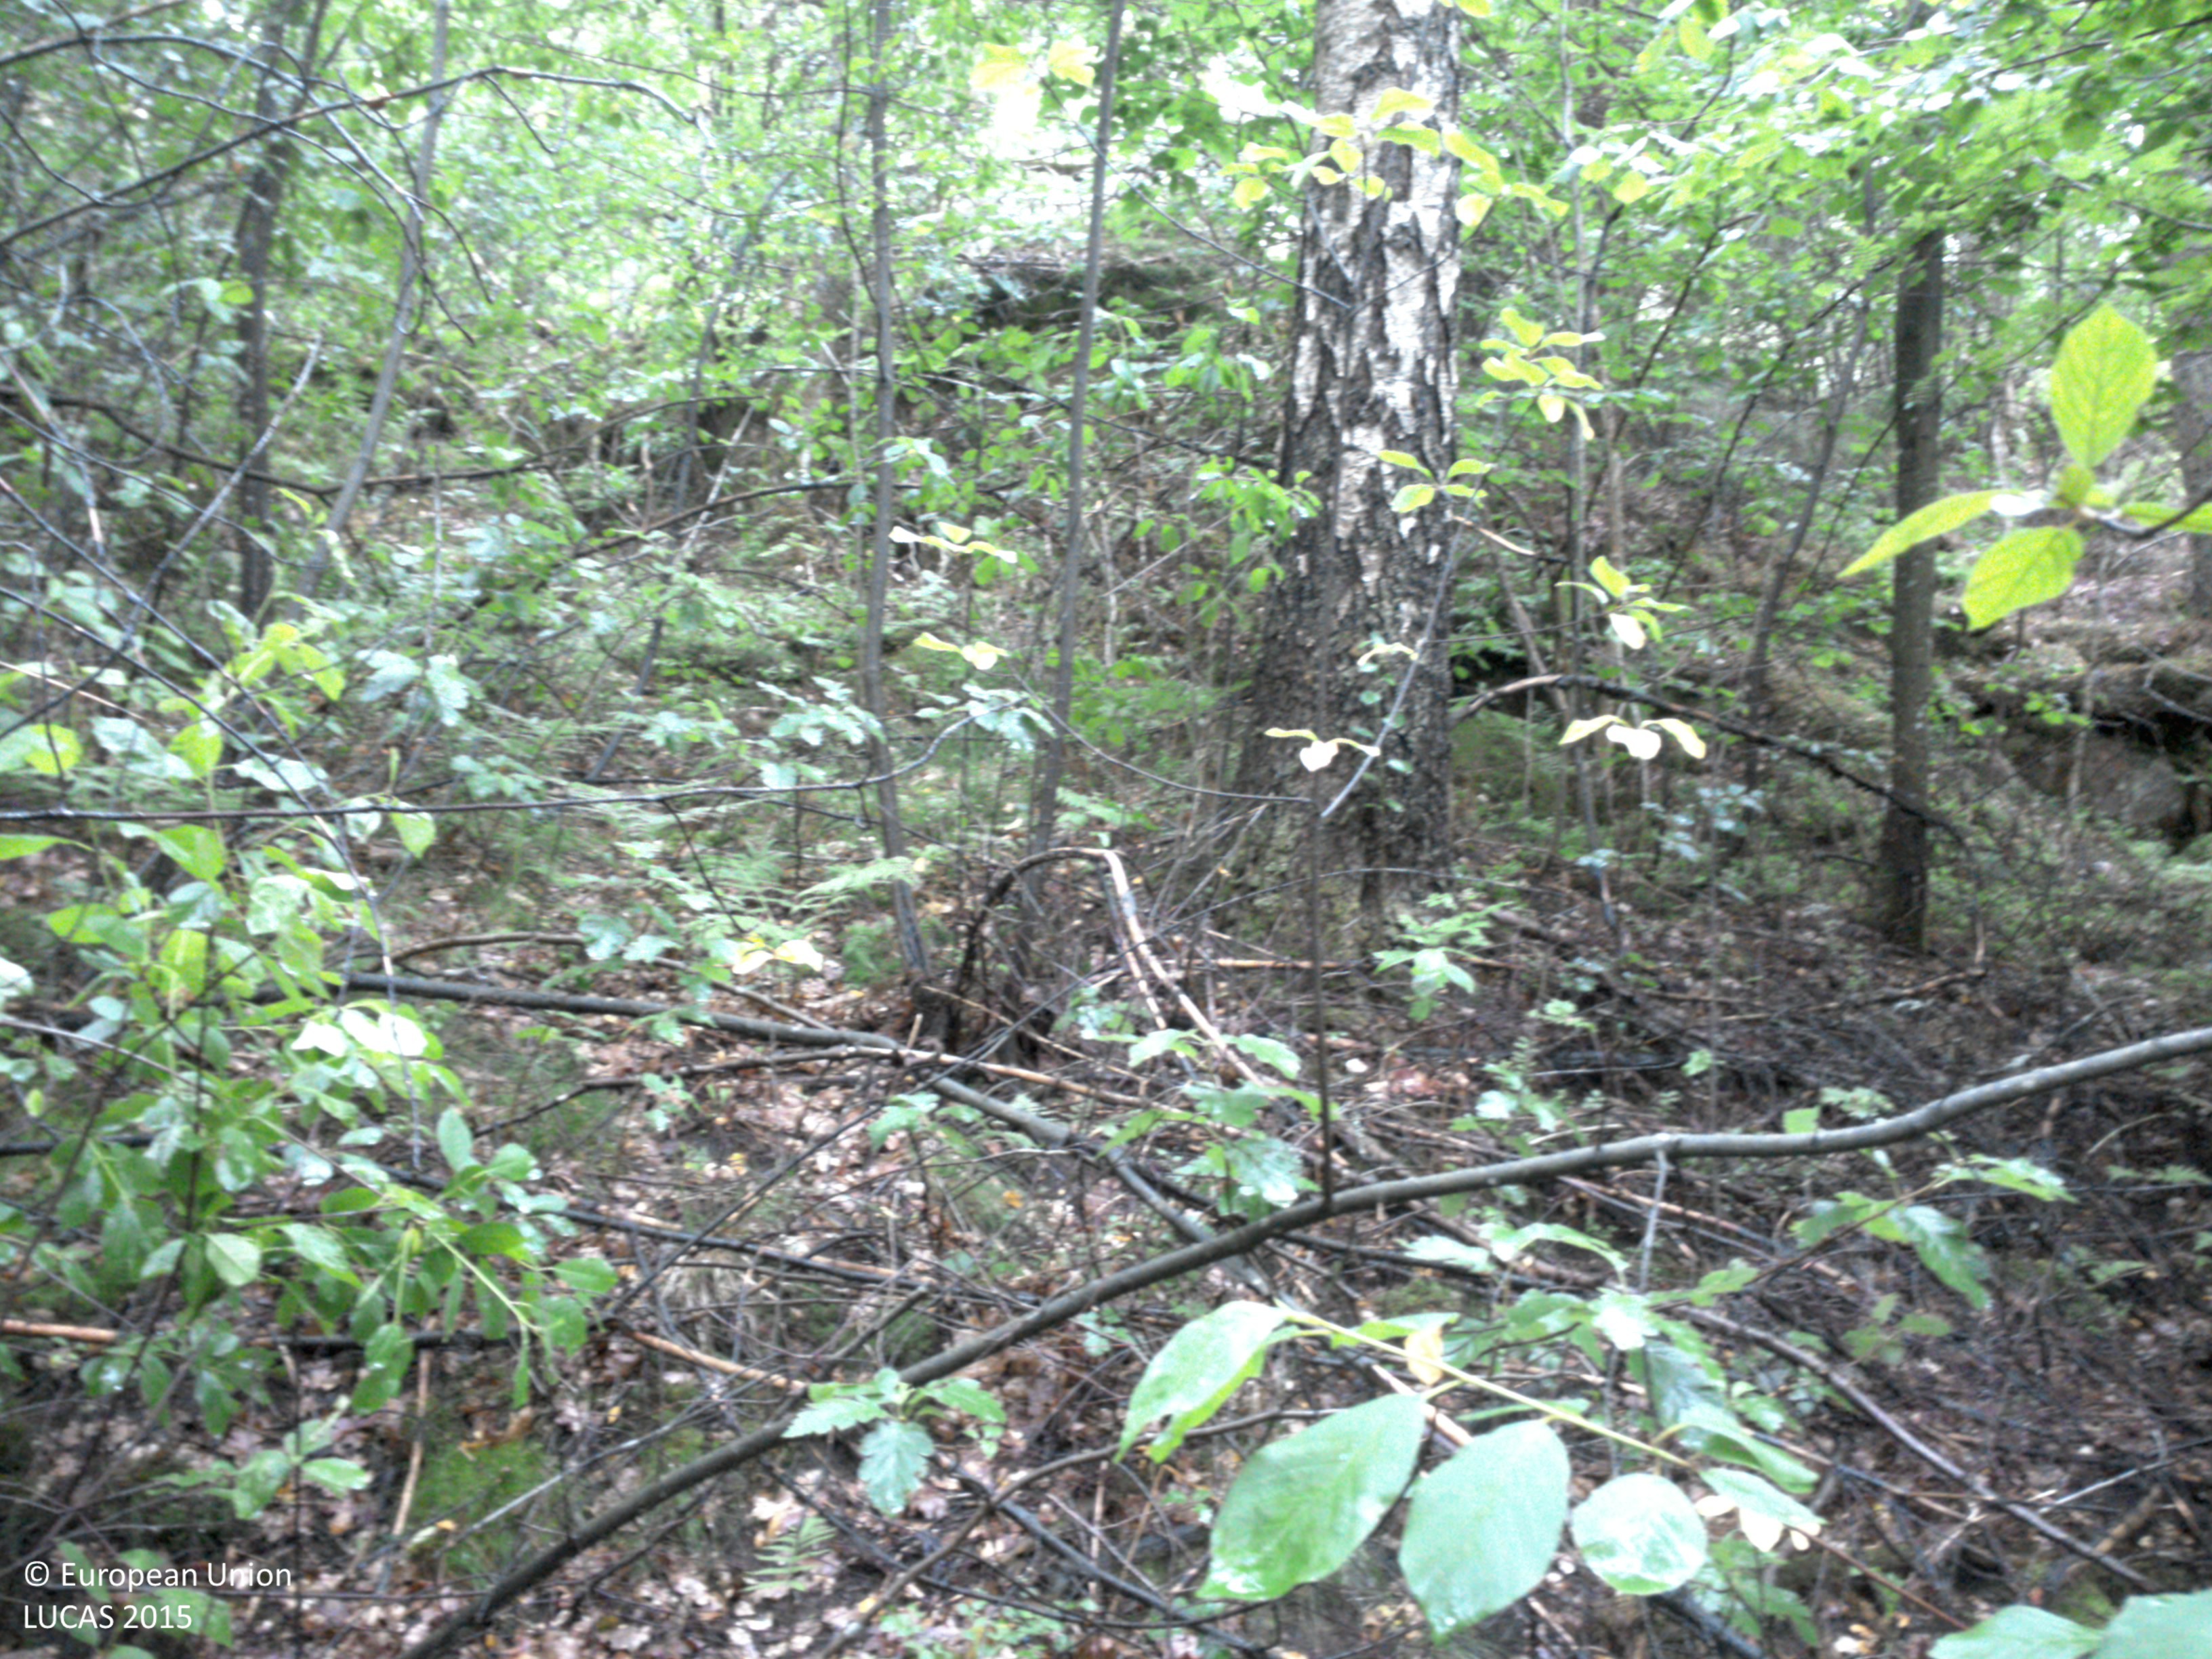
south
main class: Woodland
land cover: Broadleaved woodland
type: hemiboreal forest and nemoral coniferous forest and mixed broadleaved-coniferous forest
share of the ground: 50 - 75 %
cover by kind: broadleaved forest trees 75 %, herbaceous plants 25 %
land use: Semi-natural and natural areas not in use
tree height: > 5 m
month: July
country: SE
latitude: 58.6742
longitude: 11.8756
